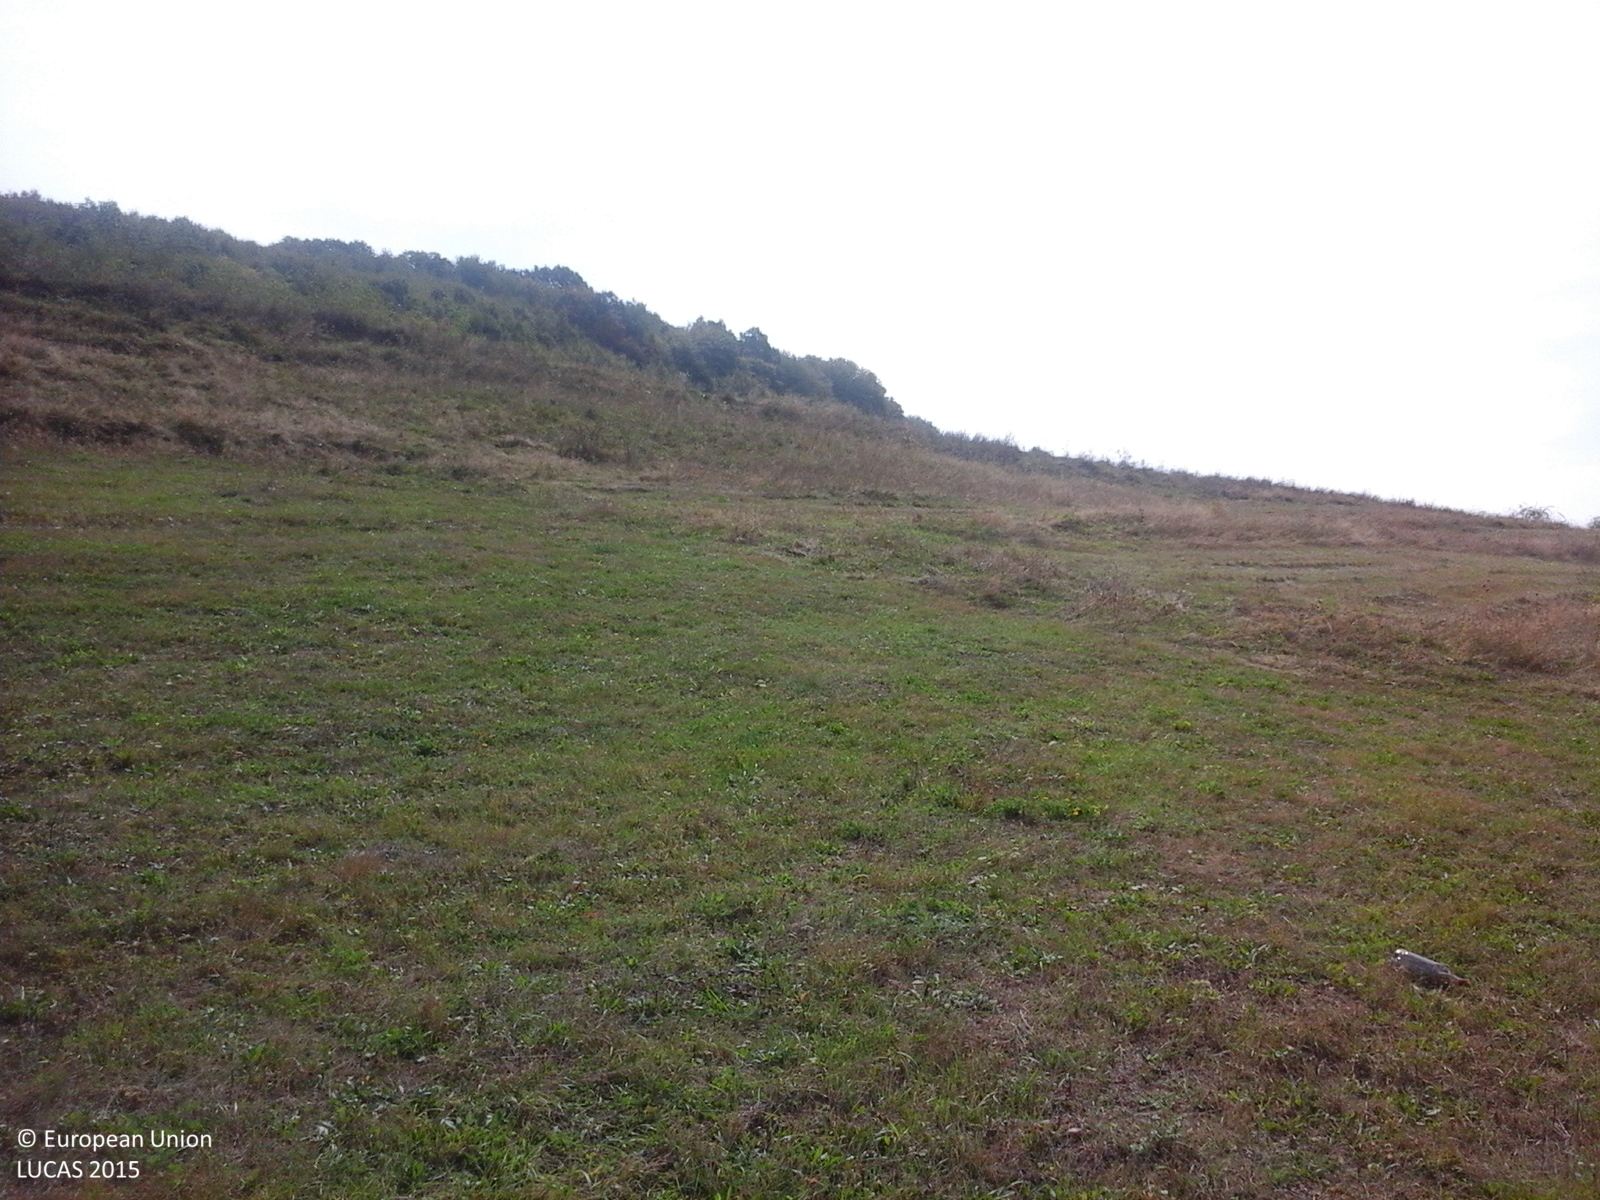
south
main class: Grassland
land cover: Grassland without tree/shrub cover
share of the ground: > 75 %
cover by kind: herbaceous plants 100 %
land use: Agriculture (excluding fallow land and kitchen gardens)
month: September
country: RO
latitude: 46.9007
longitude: 24.1679
